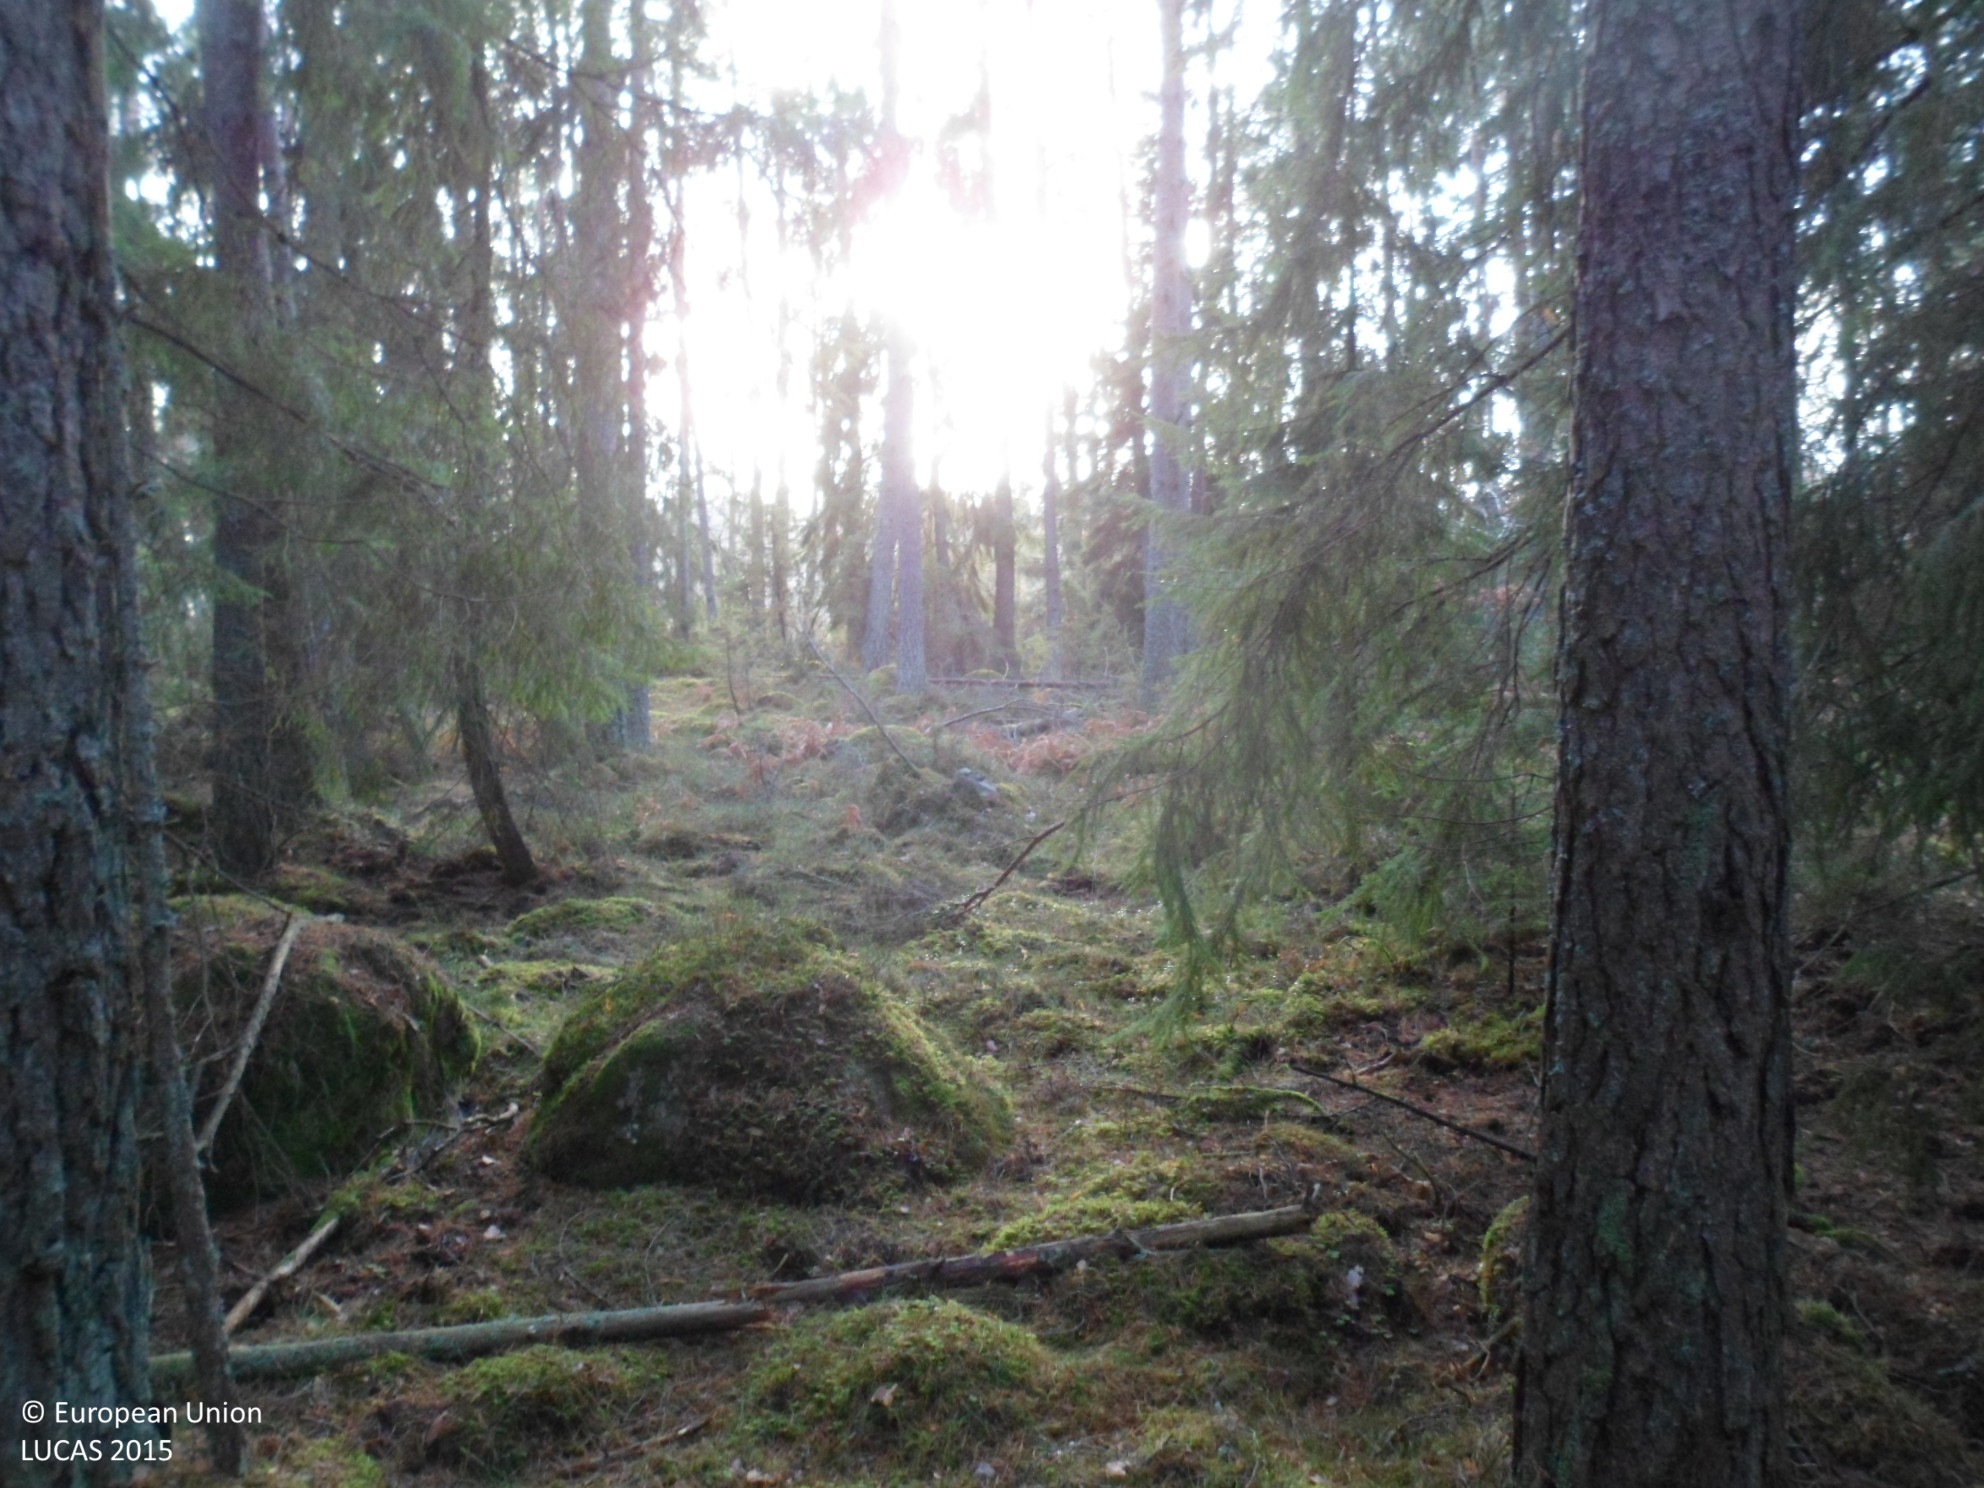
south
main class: Woodland
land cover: Other coniferous woodland
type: boreal forest
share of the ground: 50 - 75 %
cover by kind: coniferous forest trees 60 %, lichens and mosses 20 %, shrubs 15 %, unconsolidated bare surface 5 %
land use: Forestry
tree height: > 5 m
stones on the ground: 10 - 25 %
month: November
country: SE
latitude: 56.9118
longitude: 16.0269
